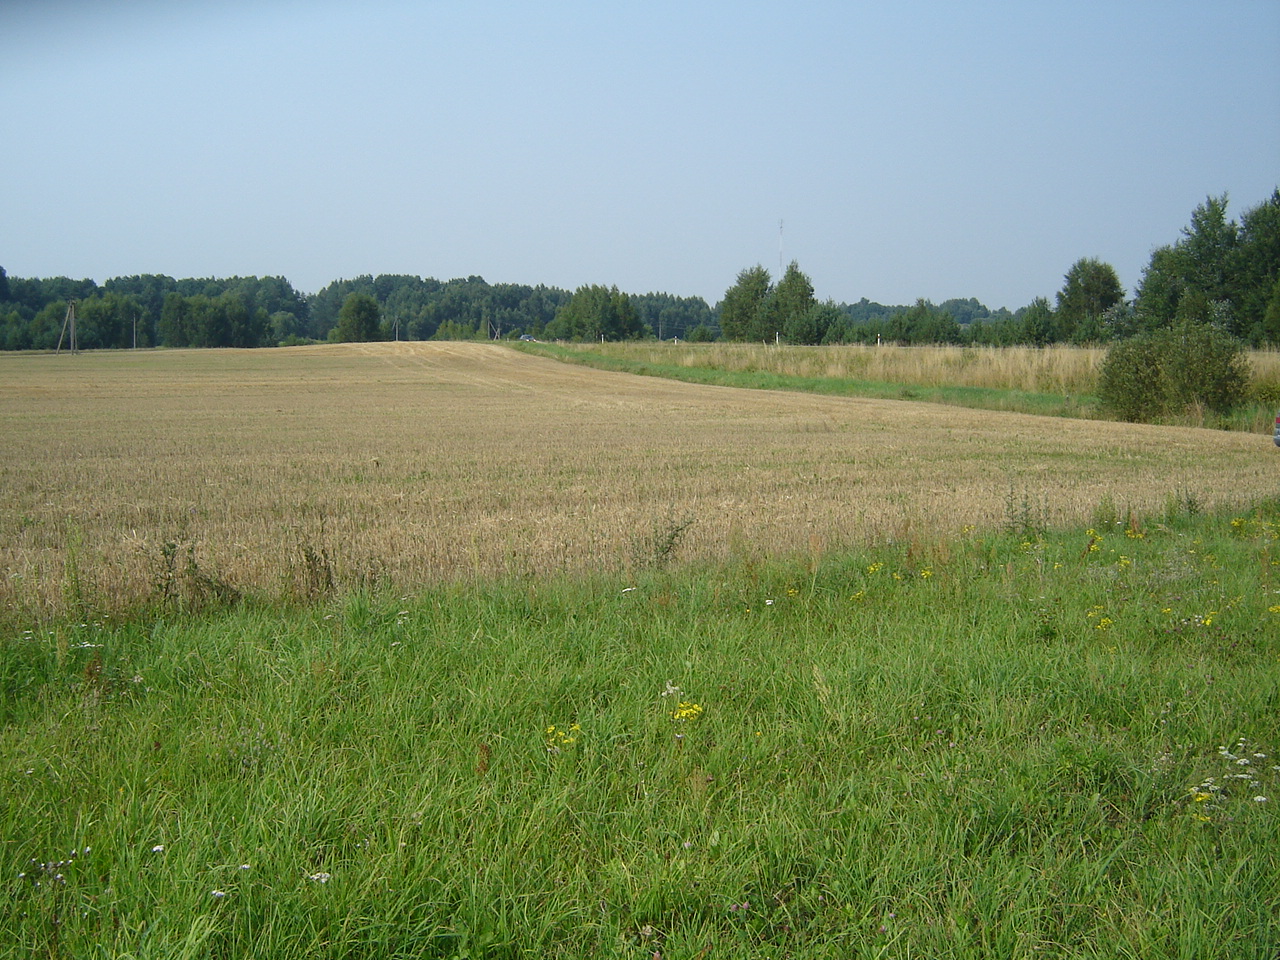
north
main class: Grassland
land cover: Grassland without tree/shrub cover
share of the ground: > 75 %
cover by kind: herbaceous plants 100 %
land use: Agriculture (excluding fallow land and kitchen gardens)
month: August
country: LT
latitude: 54.8960
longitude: 24.8451
